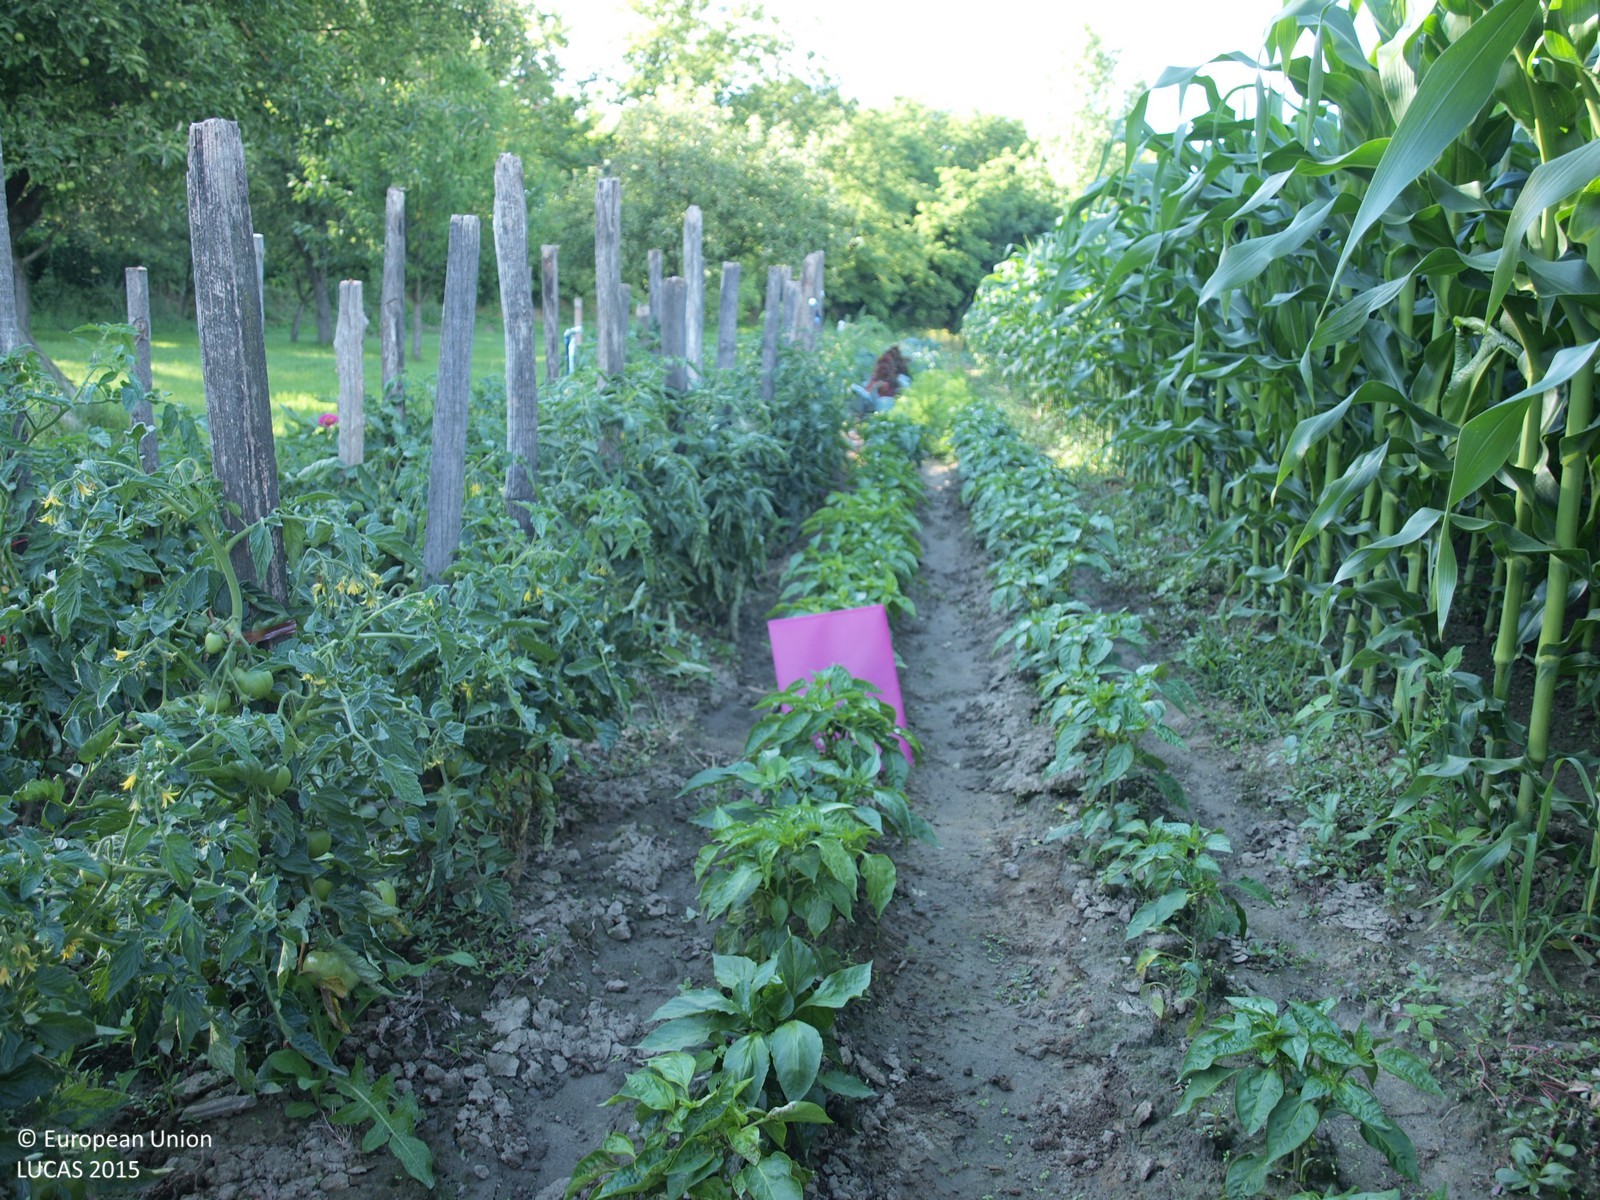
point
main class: Cropland
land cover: Other fresh vegetables
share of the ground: 50 - 75 %
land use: Agriculture (excluding fallow land and kitchen gardens)
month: June
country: HR
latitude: 46.2849
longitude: 16.7114
